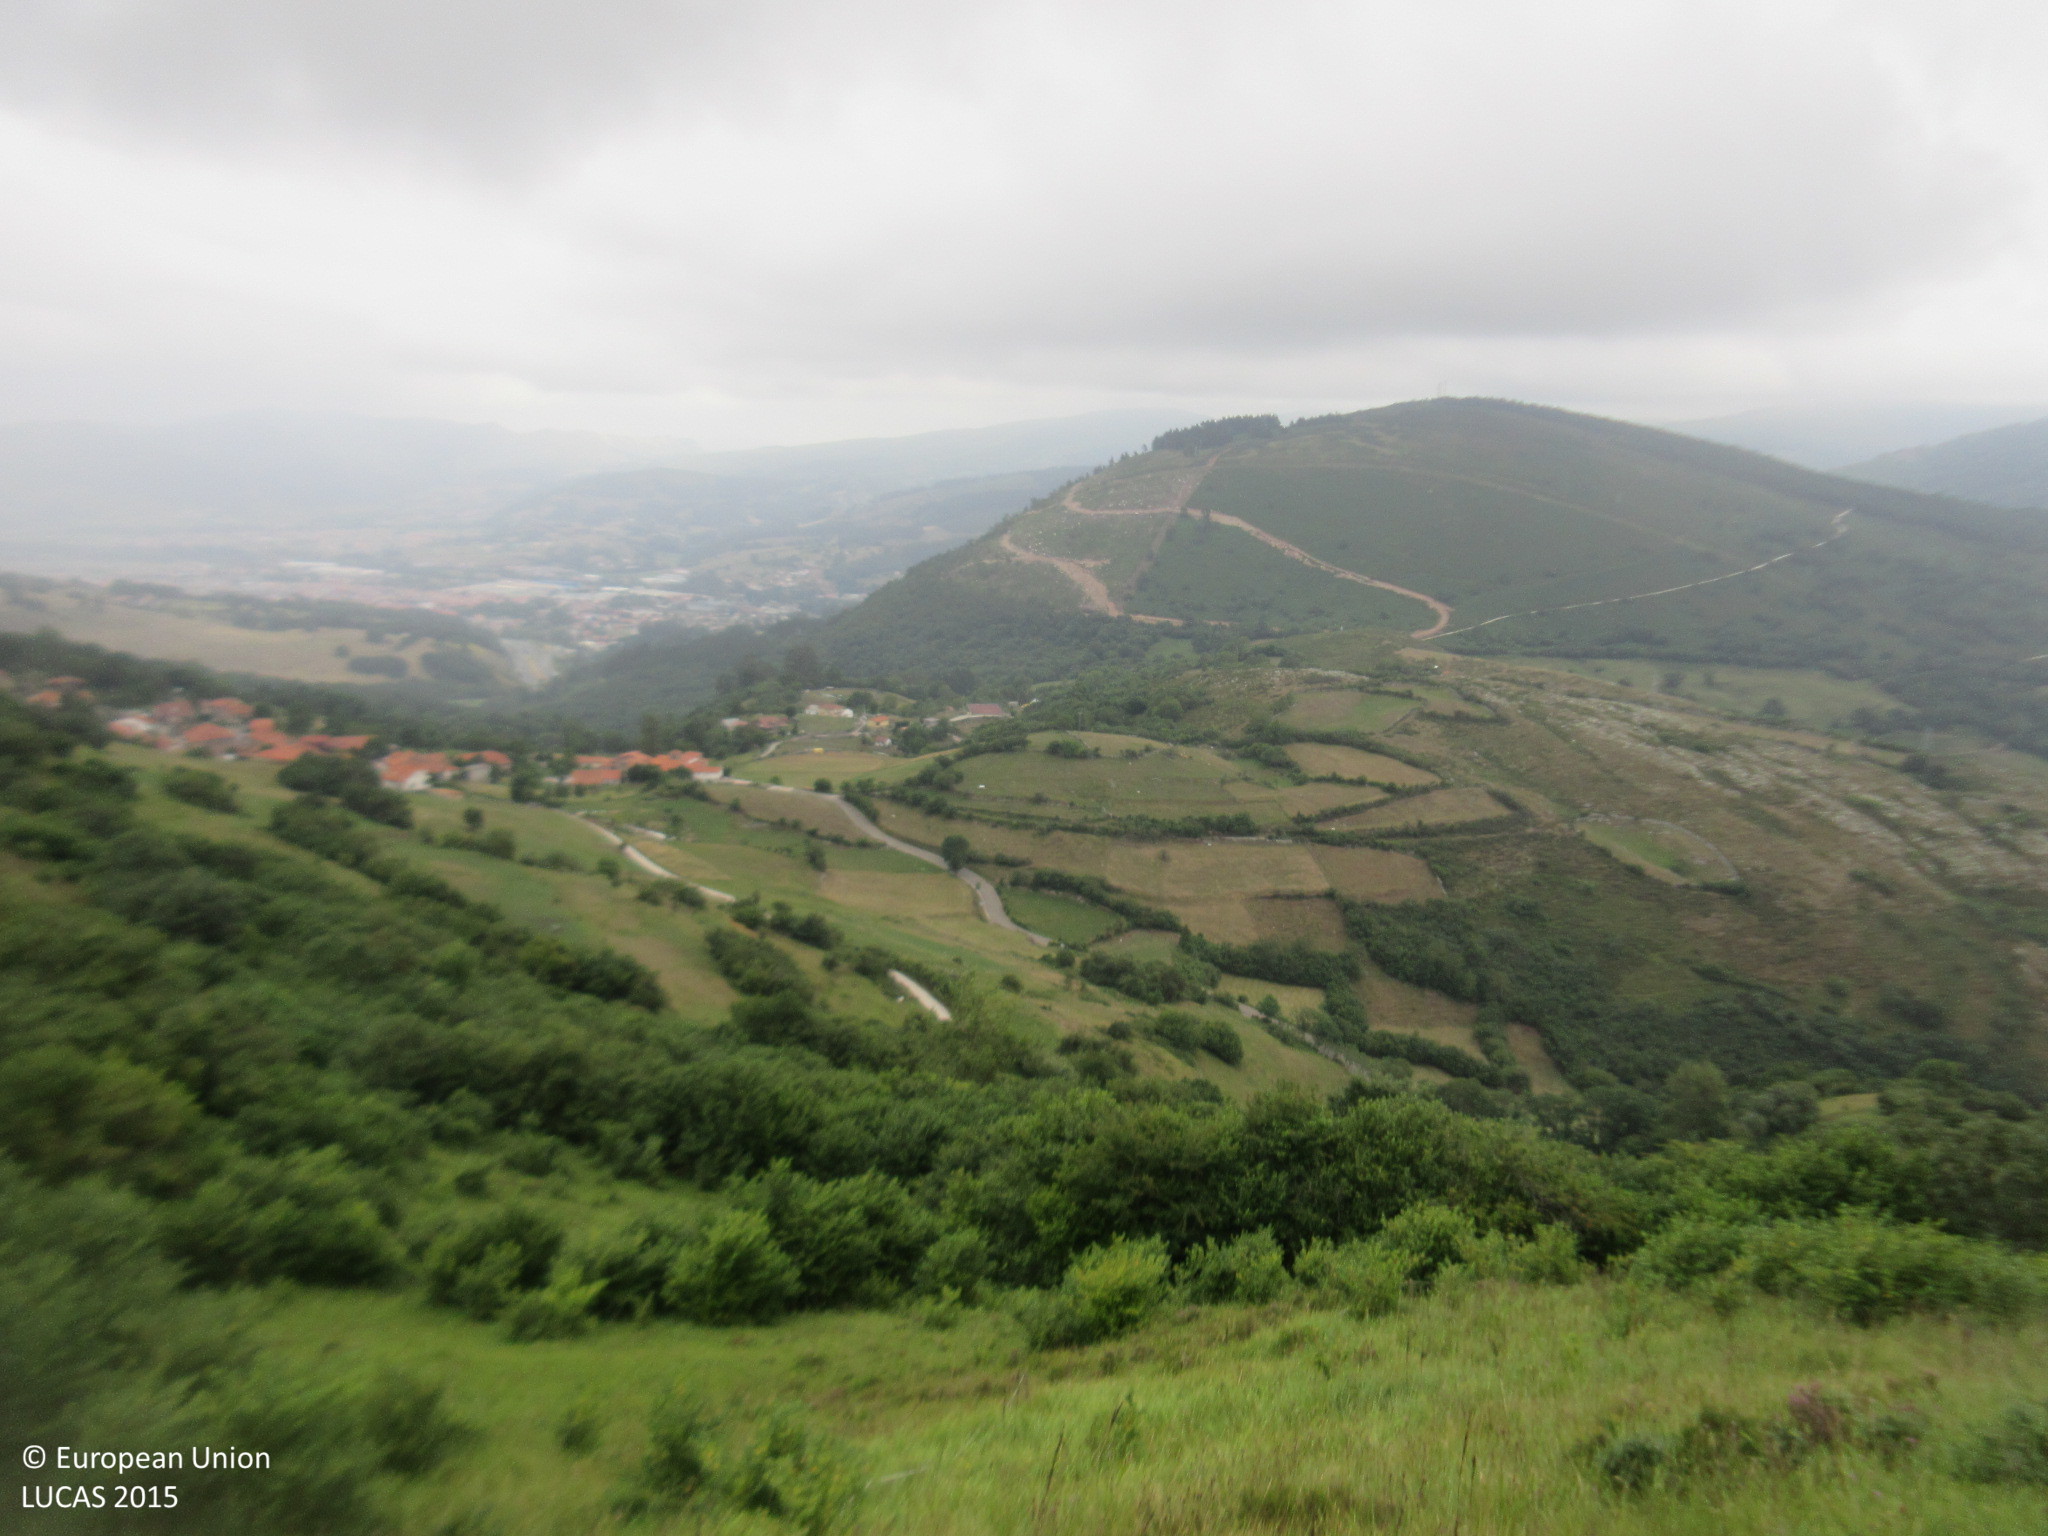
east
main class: Grassland
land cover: Grassland without tree/shrub cover
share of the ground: > 75 %
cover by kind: herbaceous plants 100 %
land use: Agriculture (excluding fallow land and kitchen gardens)
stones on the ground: < 10 %
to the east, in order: Grassland without tree/shrub cover; Grassland with sparse tree/shrub cover; Broadleaved woodland; Grassland without tree/shrub cover; Abandoned hedges; Shrubland without tree cover; Tracks; Abandoned hedges; Grassland without tree/shrub cover; Broadleaved woodland
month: July
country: ES
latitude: 43.2356
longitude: -4.1020
